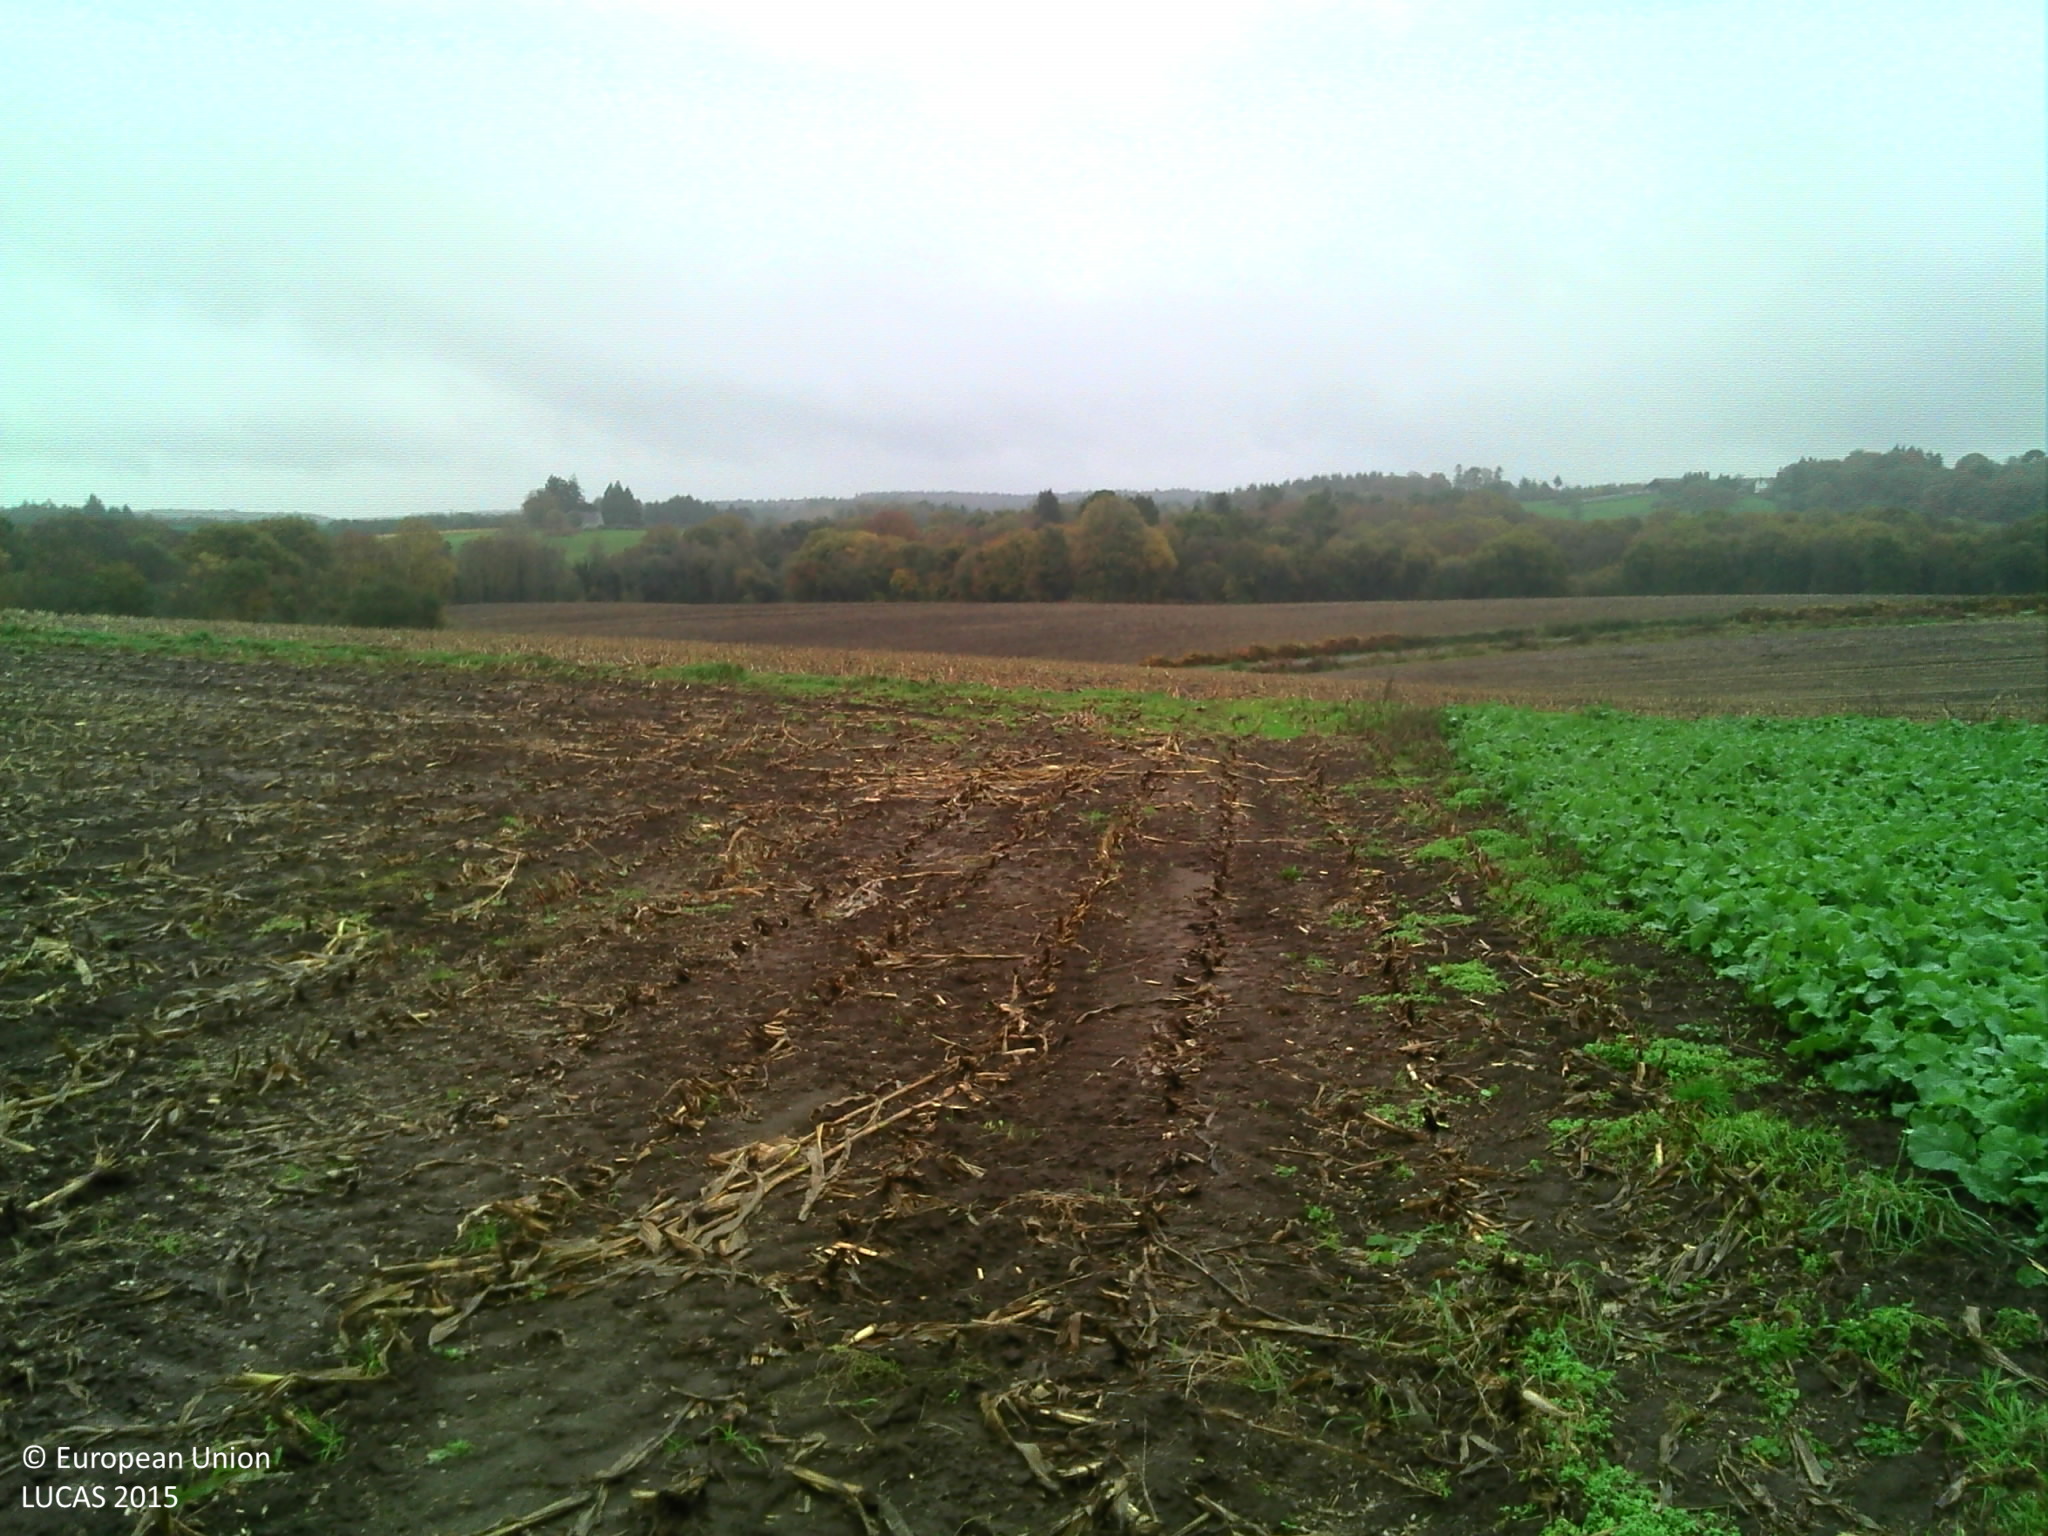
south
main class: Cropland
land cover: Rape and turnip rape
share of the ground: > 75 %
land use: Agriculture (excluding fallow land and kitchen gardens)
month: November
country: FR
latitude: 47.9502
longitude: -3.2336
